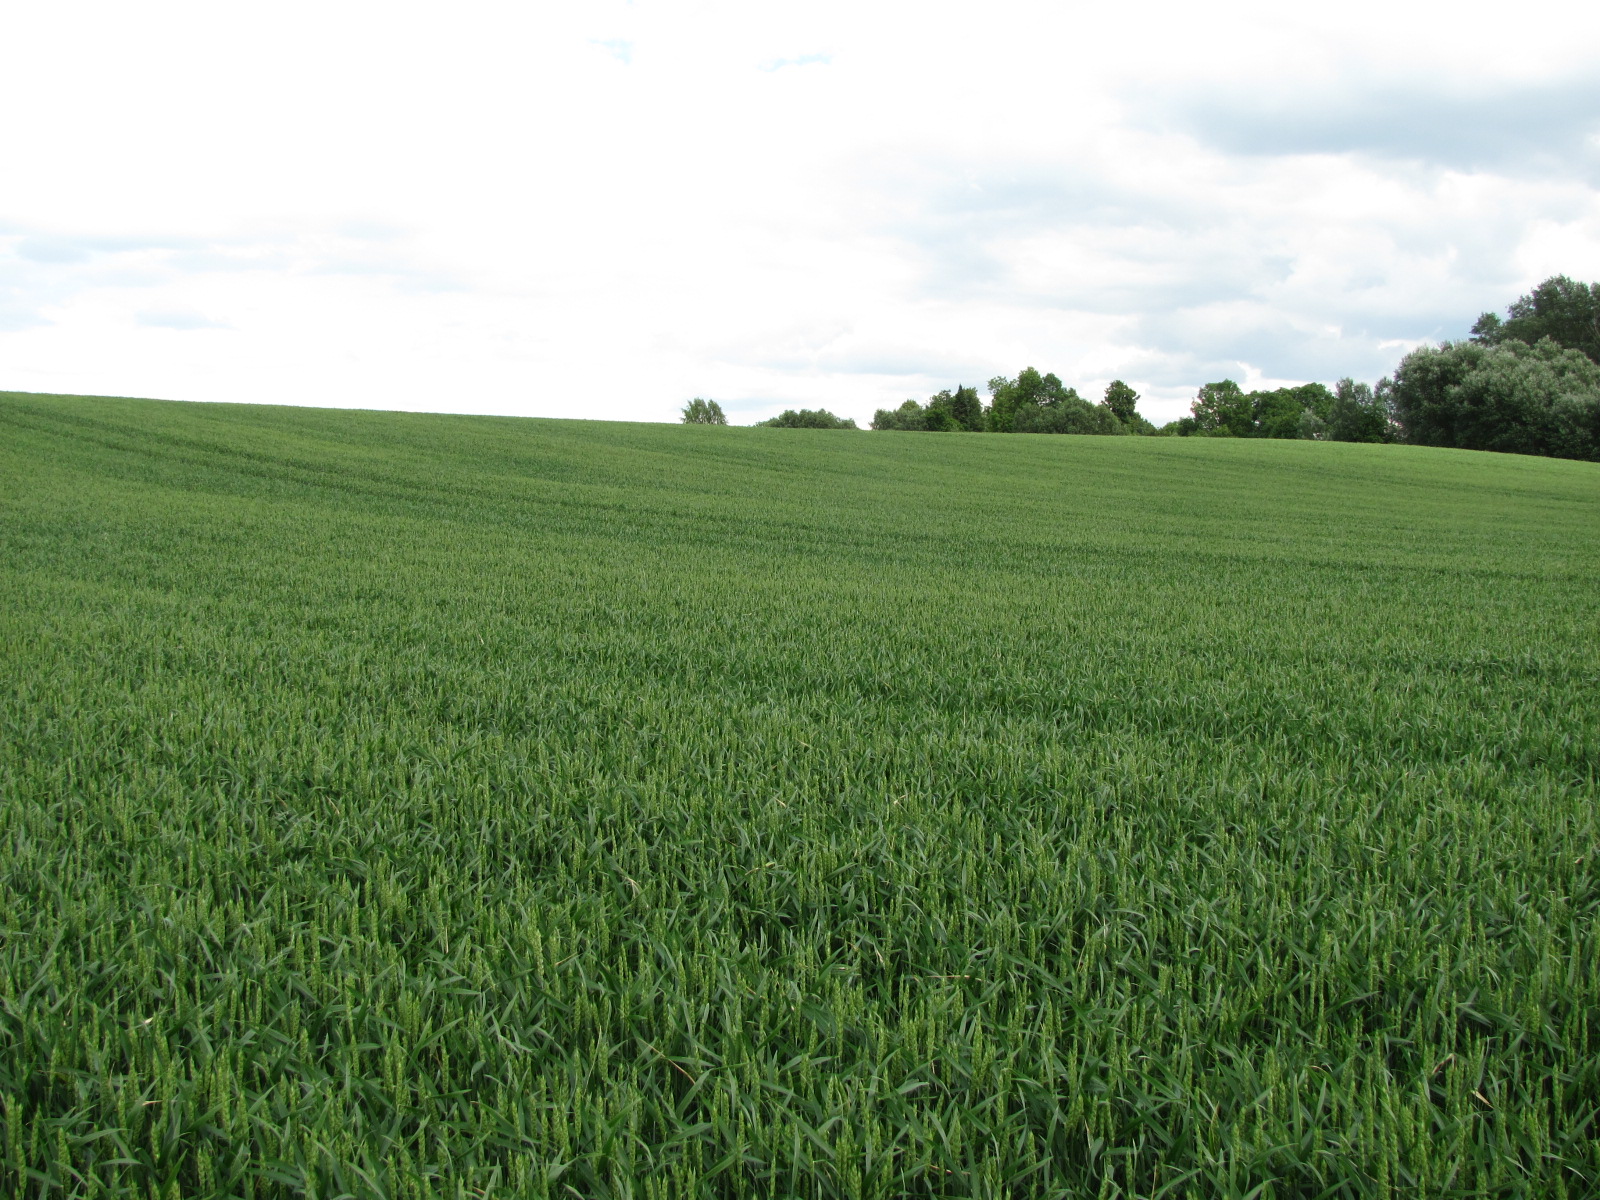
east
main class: Cropland
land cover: Common wheat
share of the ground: > 75 %
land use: Agriculture (excluding fallow land and kitchen gardens)
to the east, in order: Common wheat
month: June
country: LV
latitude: 56.4756
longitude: 23.9985
